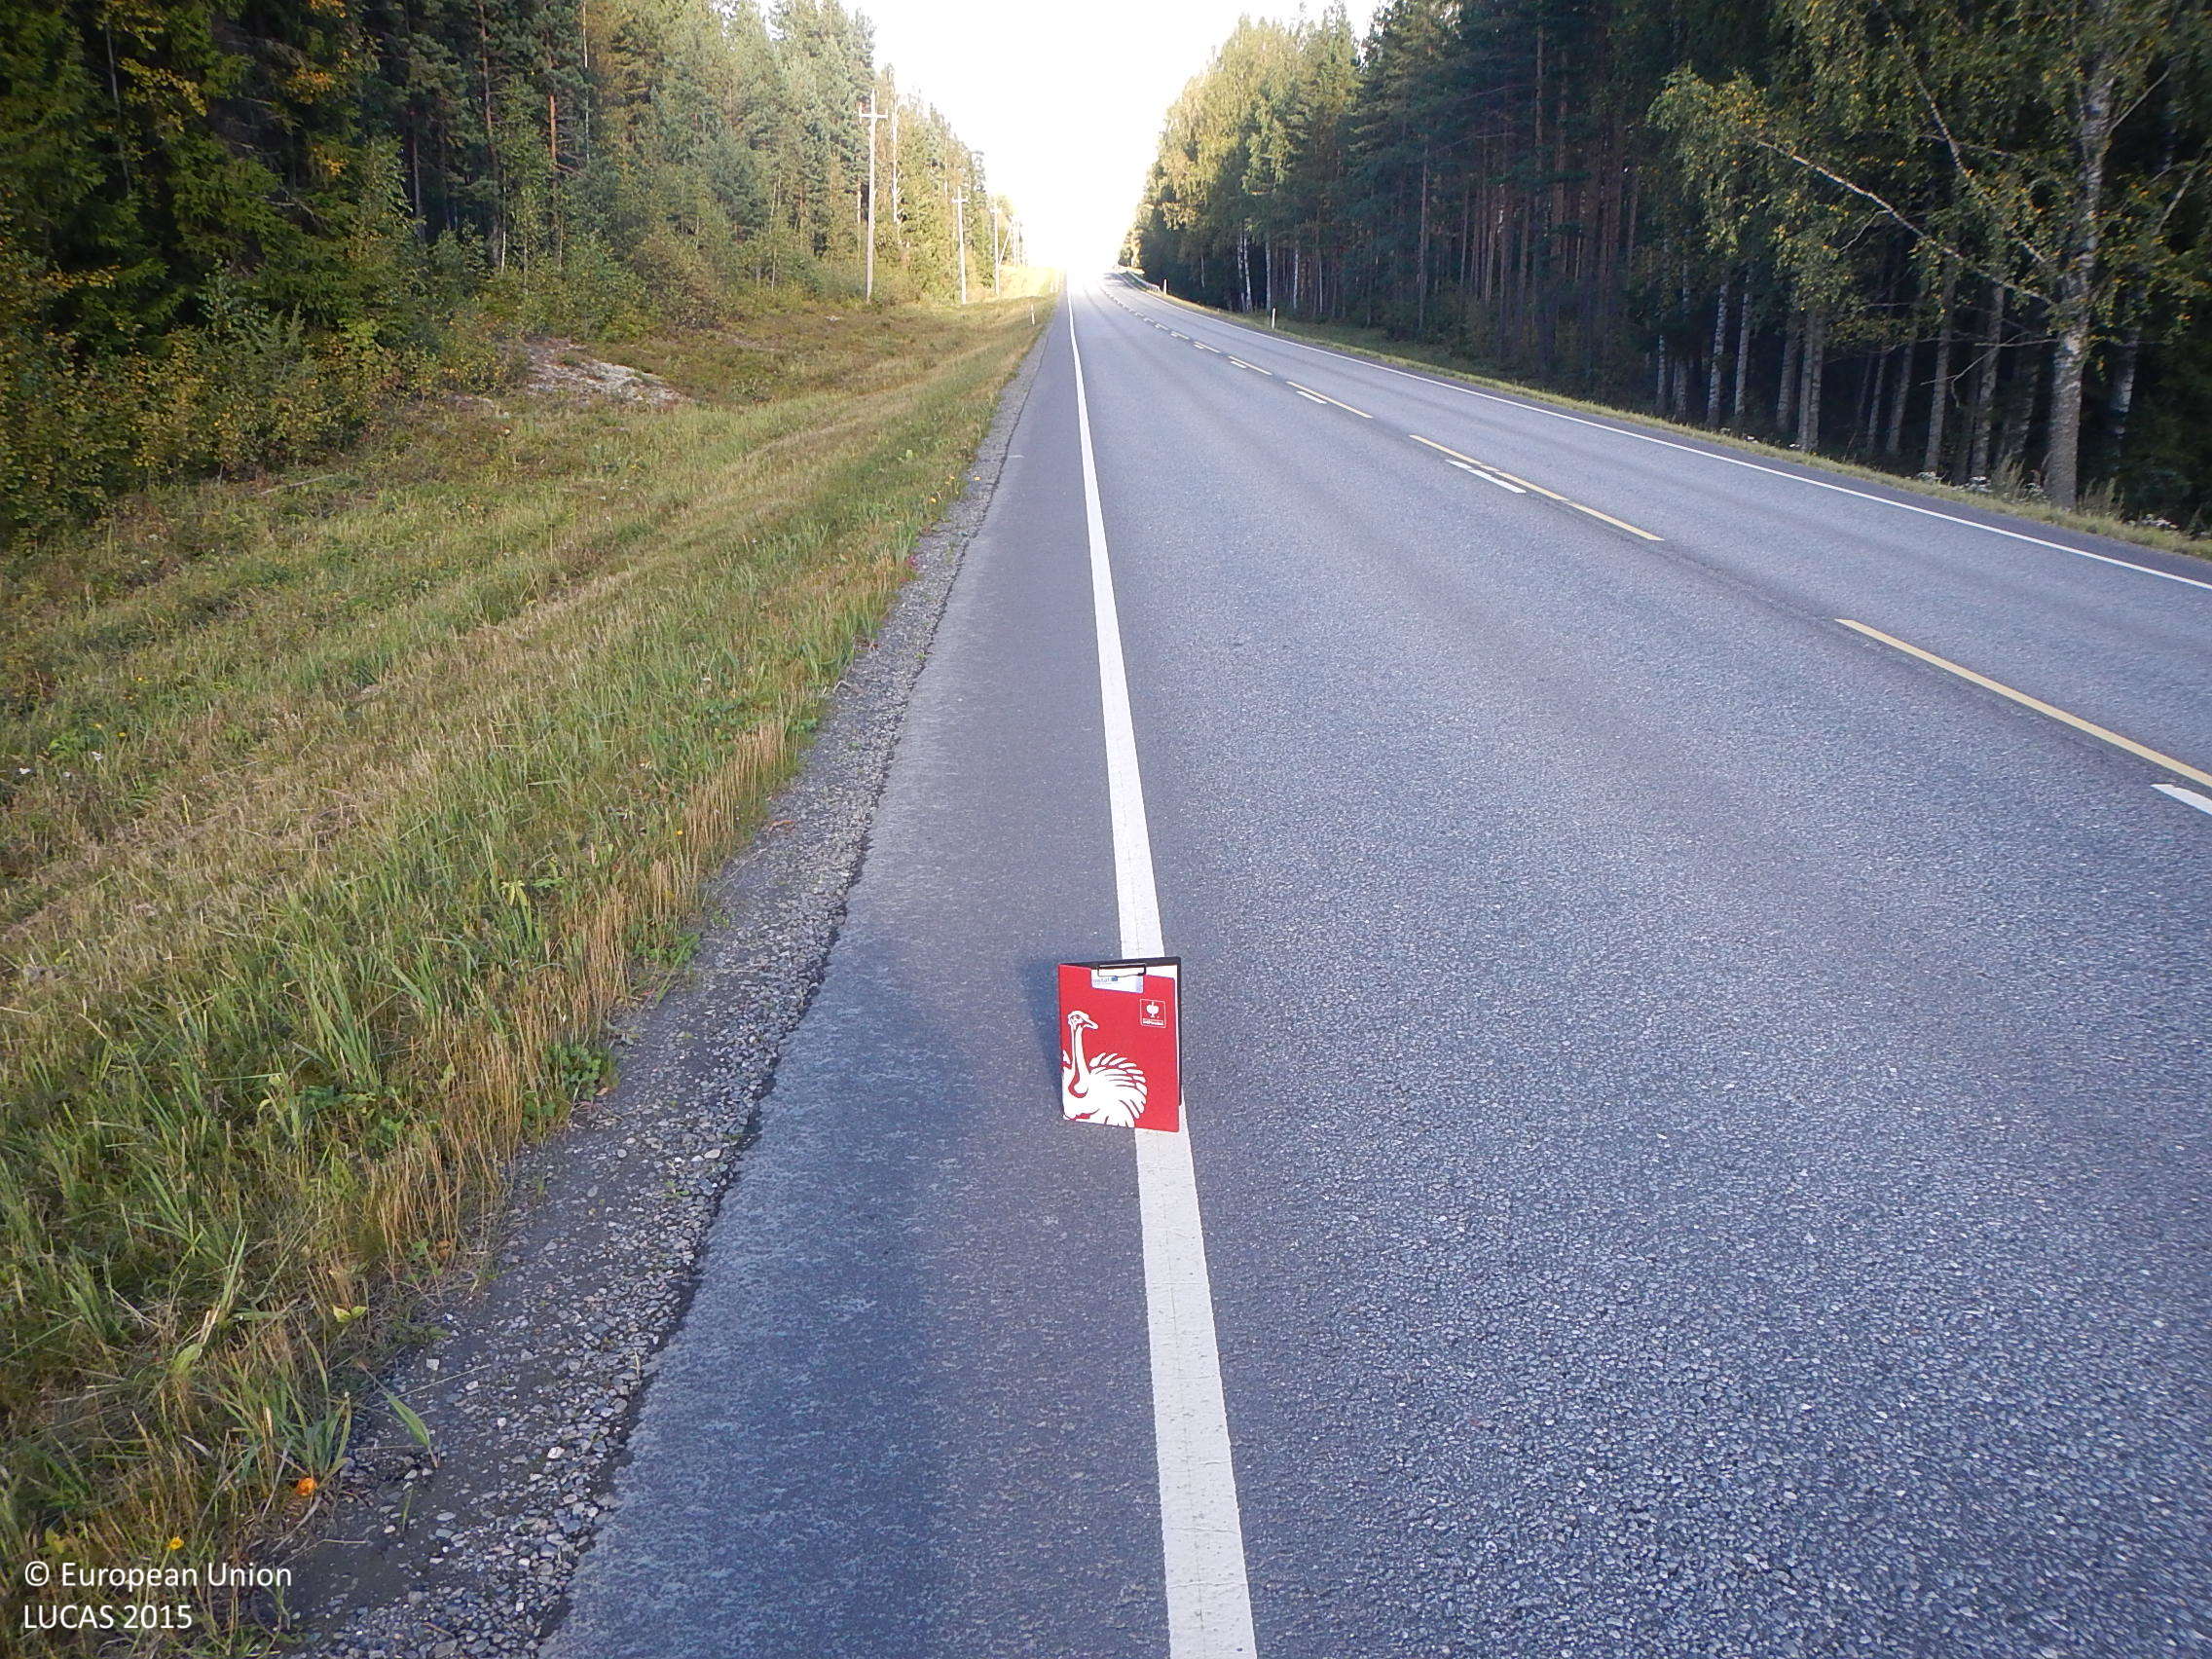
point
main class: Grassland
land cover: Grassland without tree/shrub cover
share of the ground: > 75 %
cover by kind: herbaceous plants 100 %
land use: Road transport
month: September
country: FI
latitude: 61.4780
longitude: 22.5868
